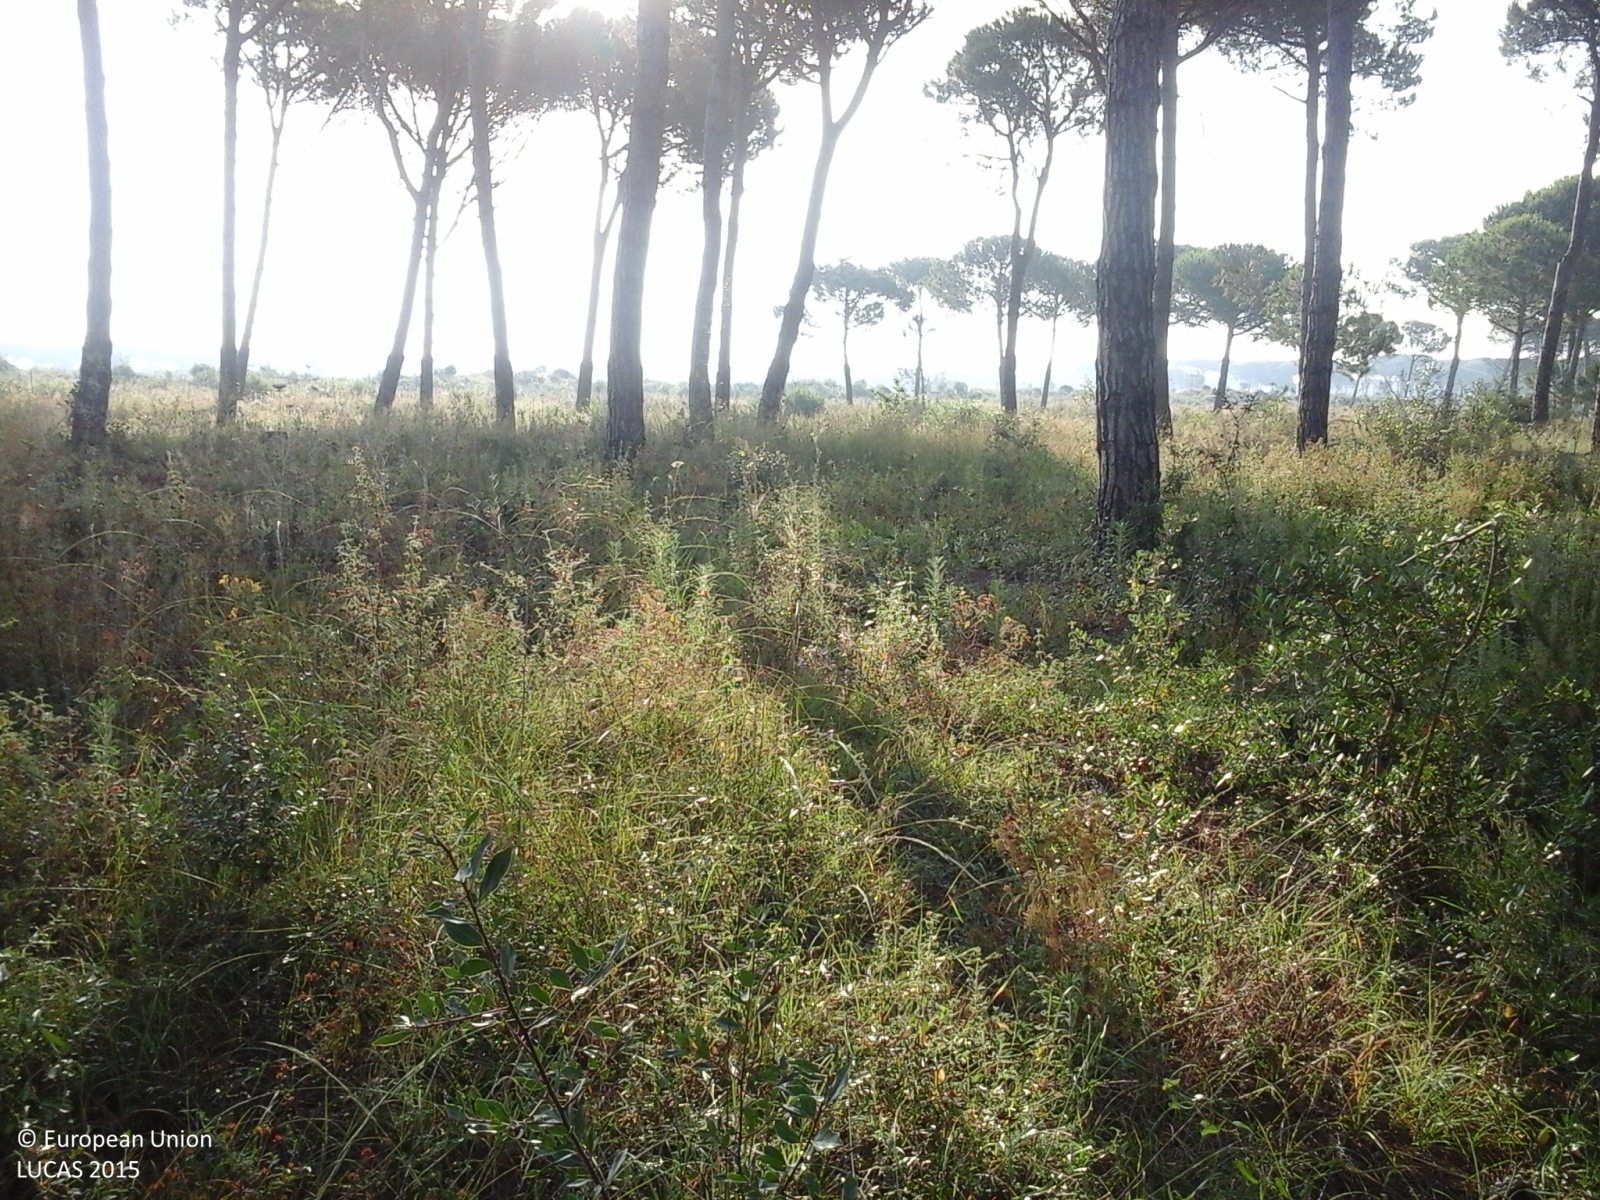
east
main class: Woodland
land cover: Pine dominated coniferous woodland
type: broadleaved evergreen forest
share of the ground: > 75 %
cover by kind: coniferous forest trees 80 %, shrubs 10 %, herbaceous plants 10 %
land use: Forestry
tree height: > 5 m
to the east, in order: Pine dominated coniferous woodland; Grassland with sparse tree/shrub cover; Tracks; Grassland with sparse tree/shrub cover; Single bushes/trees; Grassland with sparse tree/shrub cover; Single bushes/trees; Grassland with sparse tree/shrub cover; Tracks; Grassland with sparse tree/shrub cover
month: July
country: IT
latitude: 42.7215
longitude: 10.9859
